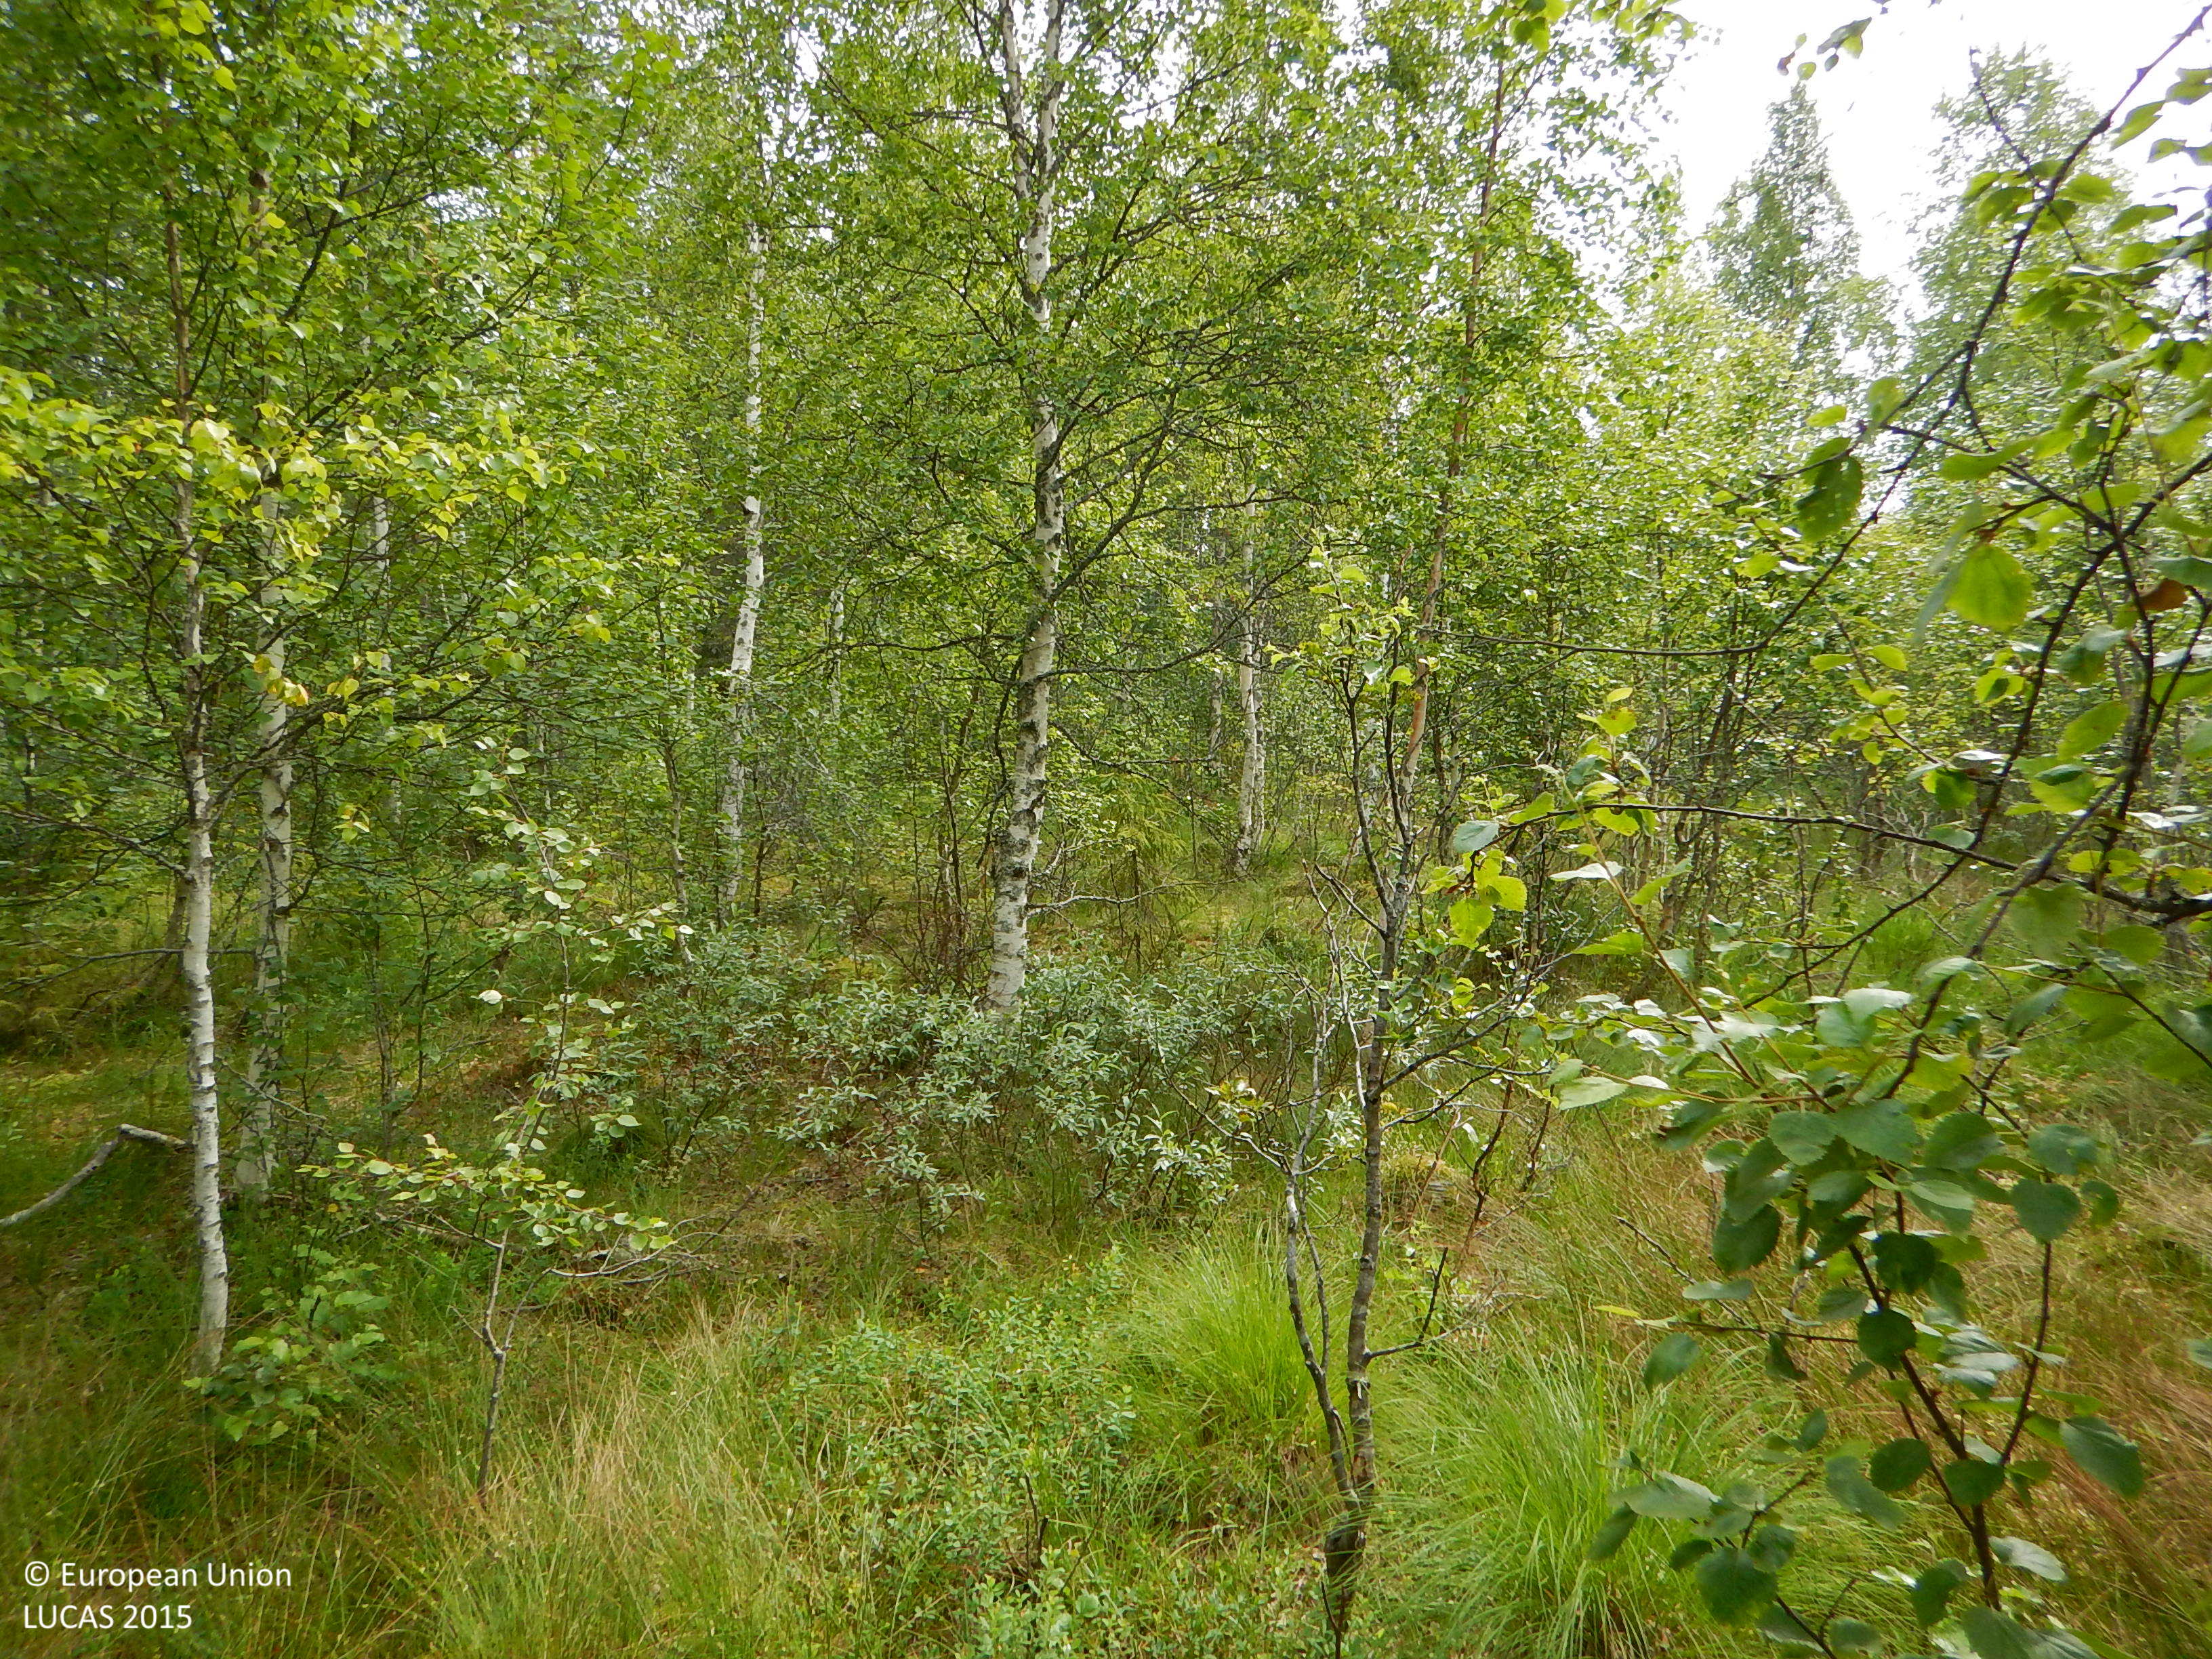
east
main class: Woodland
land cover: Broadleaved woodland
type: boreal forest
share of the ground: 50 - 75 %
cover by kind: broadleaved forest trees 50 %, herbaceous plants 15 %, lichens and mosses 15 %, coniferous forest trees 10 %, shrubs 10 %
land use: Forestry
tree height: > 5 m
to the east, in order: Broadleaved woodland; Ditches and canals; Other mixed woodland; Ditches and canals; Other mixed woodland; Ditches and canals; Other bare soil; Other mixed woodland; Rivers and streams; Broadleaved woodland; Spruce dominated mixed woodland; Pine dominated mixed woodland; Shrubland with sparse tree cover
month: July
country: SE
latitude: 65.0164
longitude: 20.2195
